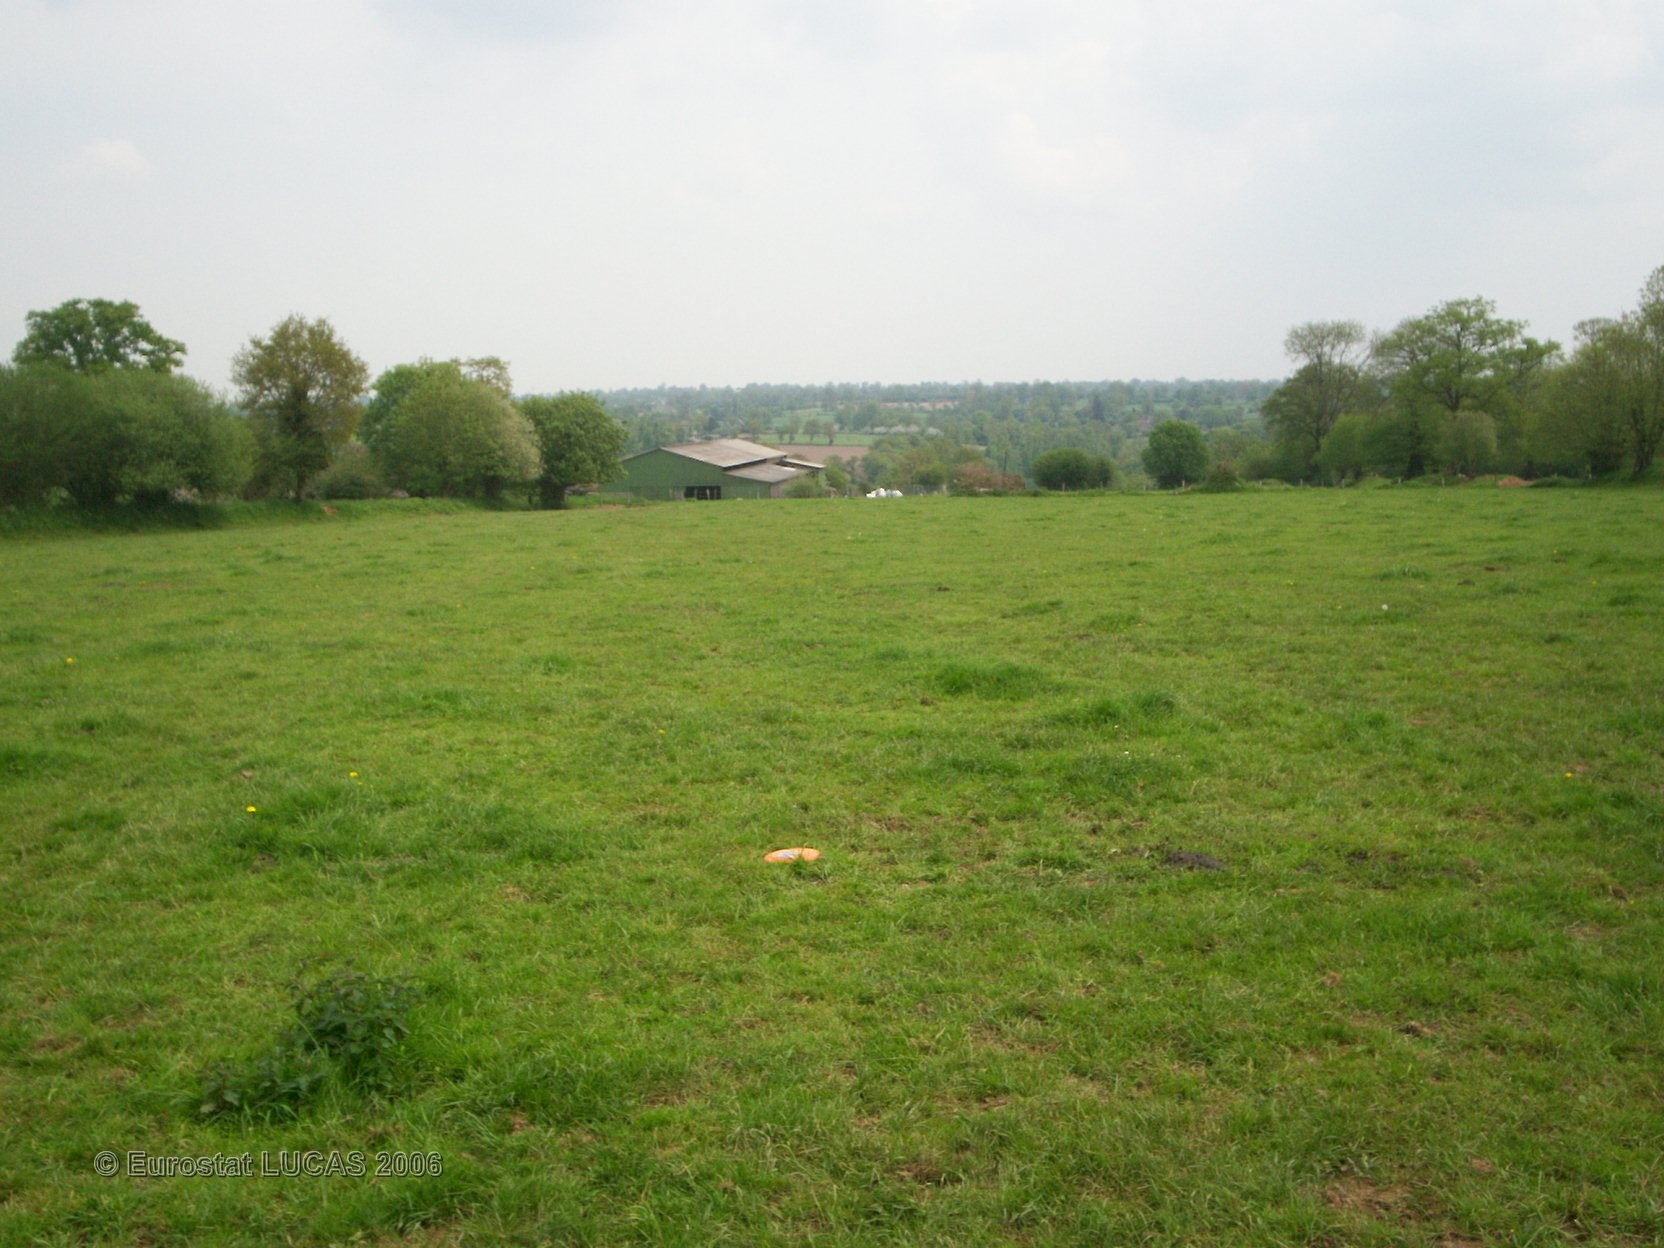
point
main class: Grassland
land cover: Grassland without tree/shrub cover
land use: Agriculture (excluding fallow land and kitchen gardens)
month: May
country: FR
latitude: 48.8503
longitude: -1.3712
